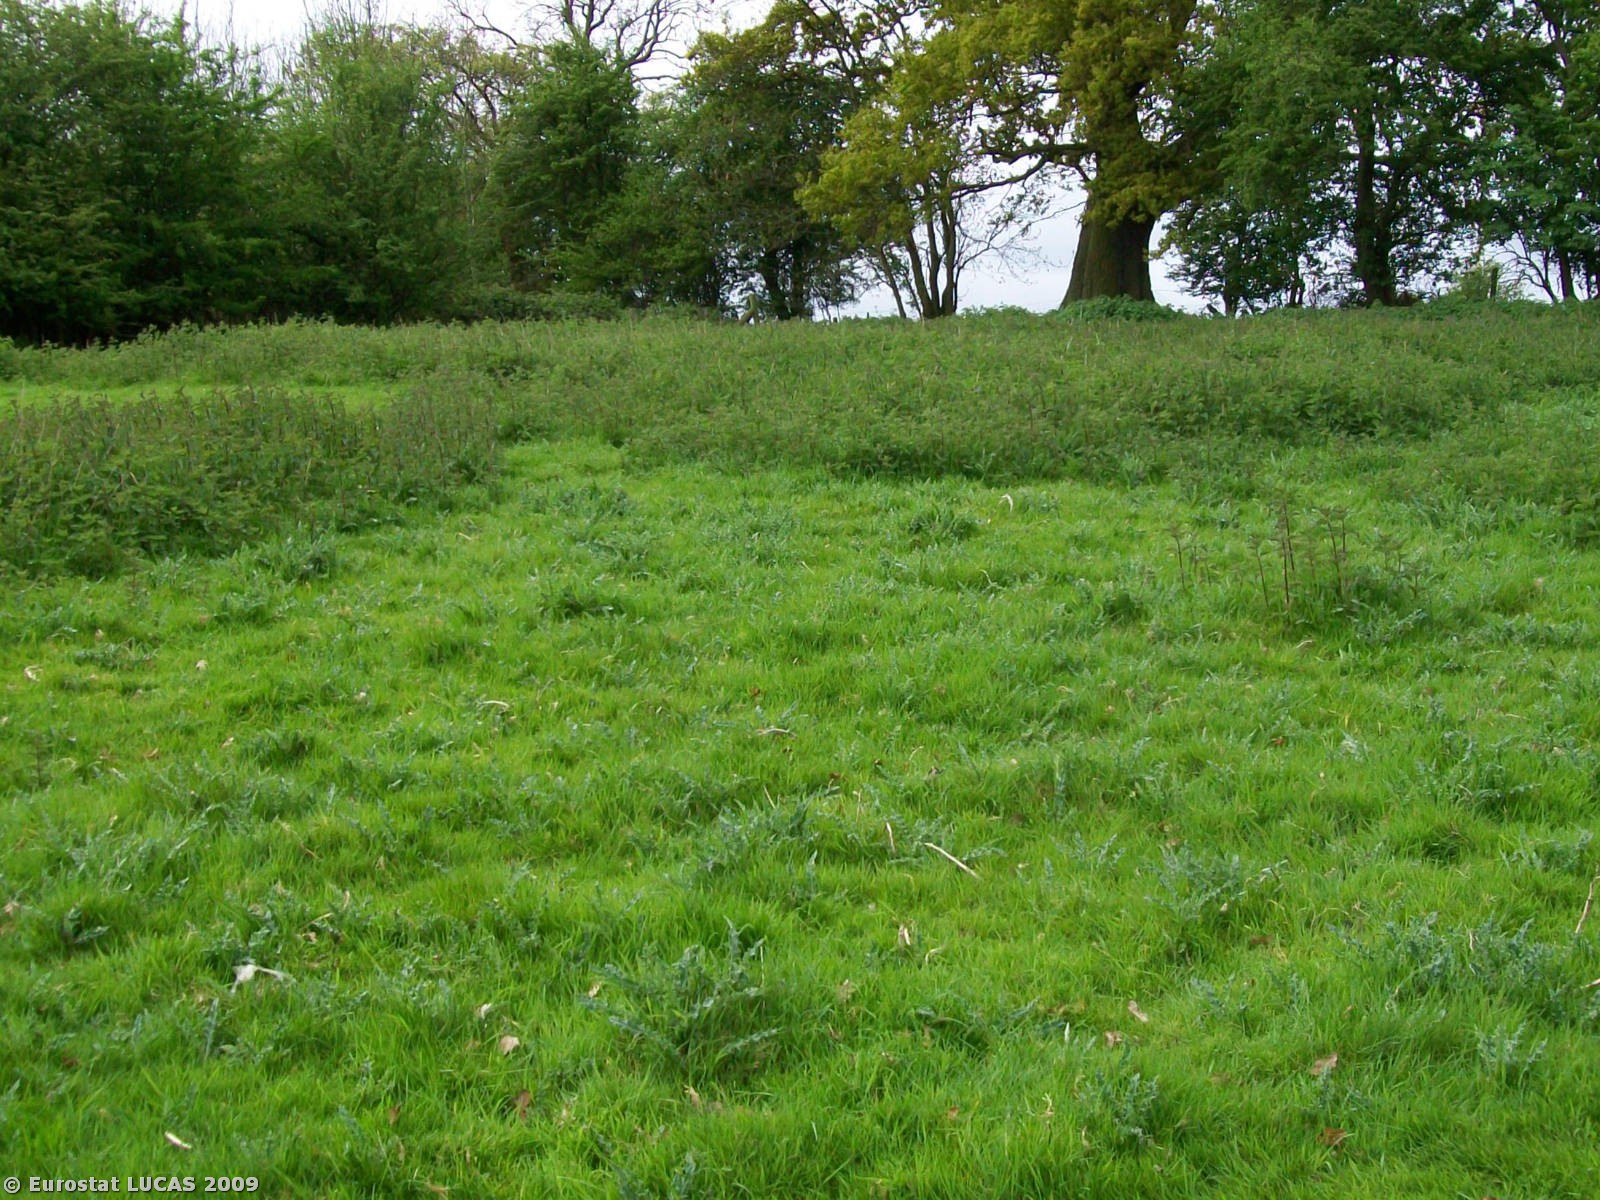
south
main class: Grassland
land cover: Grassland without tree/shrub cover
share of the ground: > 75 %
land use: Agriculture (excluding fallow land and kitchen gardens)
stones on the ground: < 10 %
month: May
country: GB
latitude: 52.3712
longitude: -2.4772
